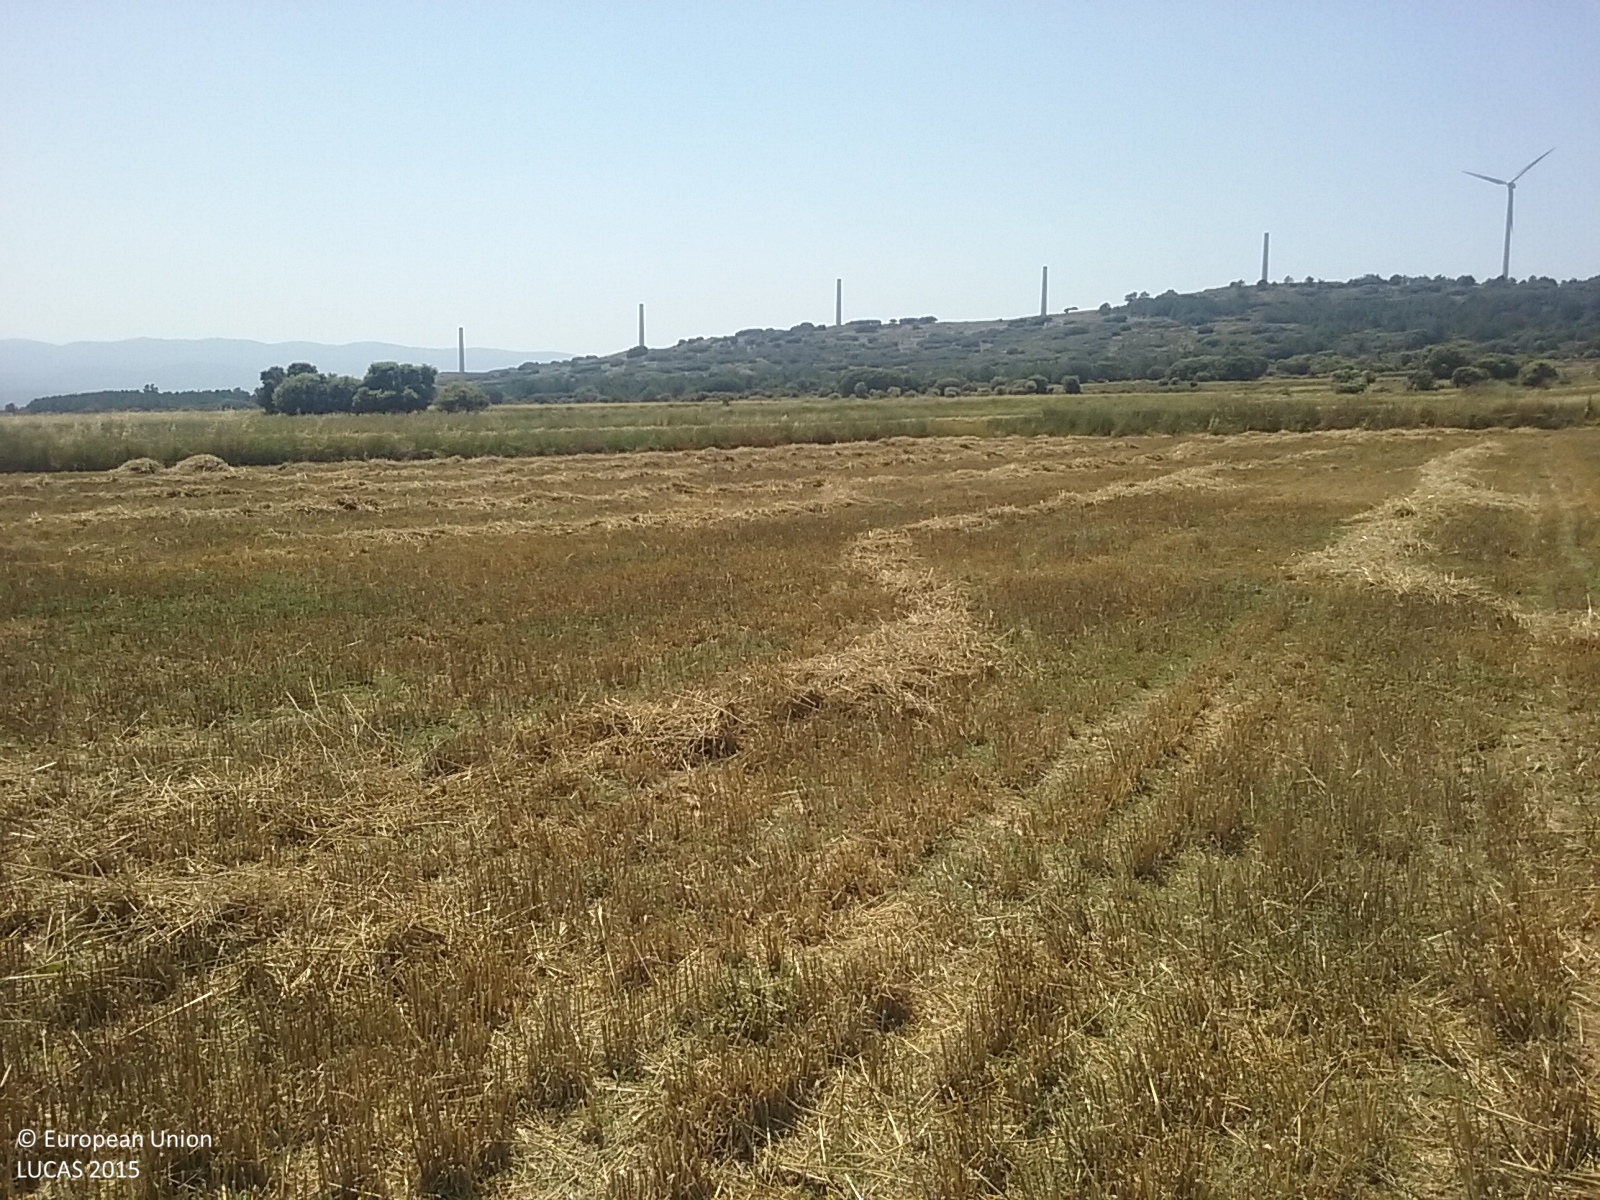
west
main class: Cropland
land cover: Barley
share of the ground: < 10 %
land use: Agriculture (excluding fallow land and kitchen gardens)
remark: Harvested field
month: July
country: ES
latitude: 39.9933
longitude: -0.6740
